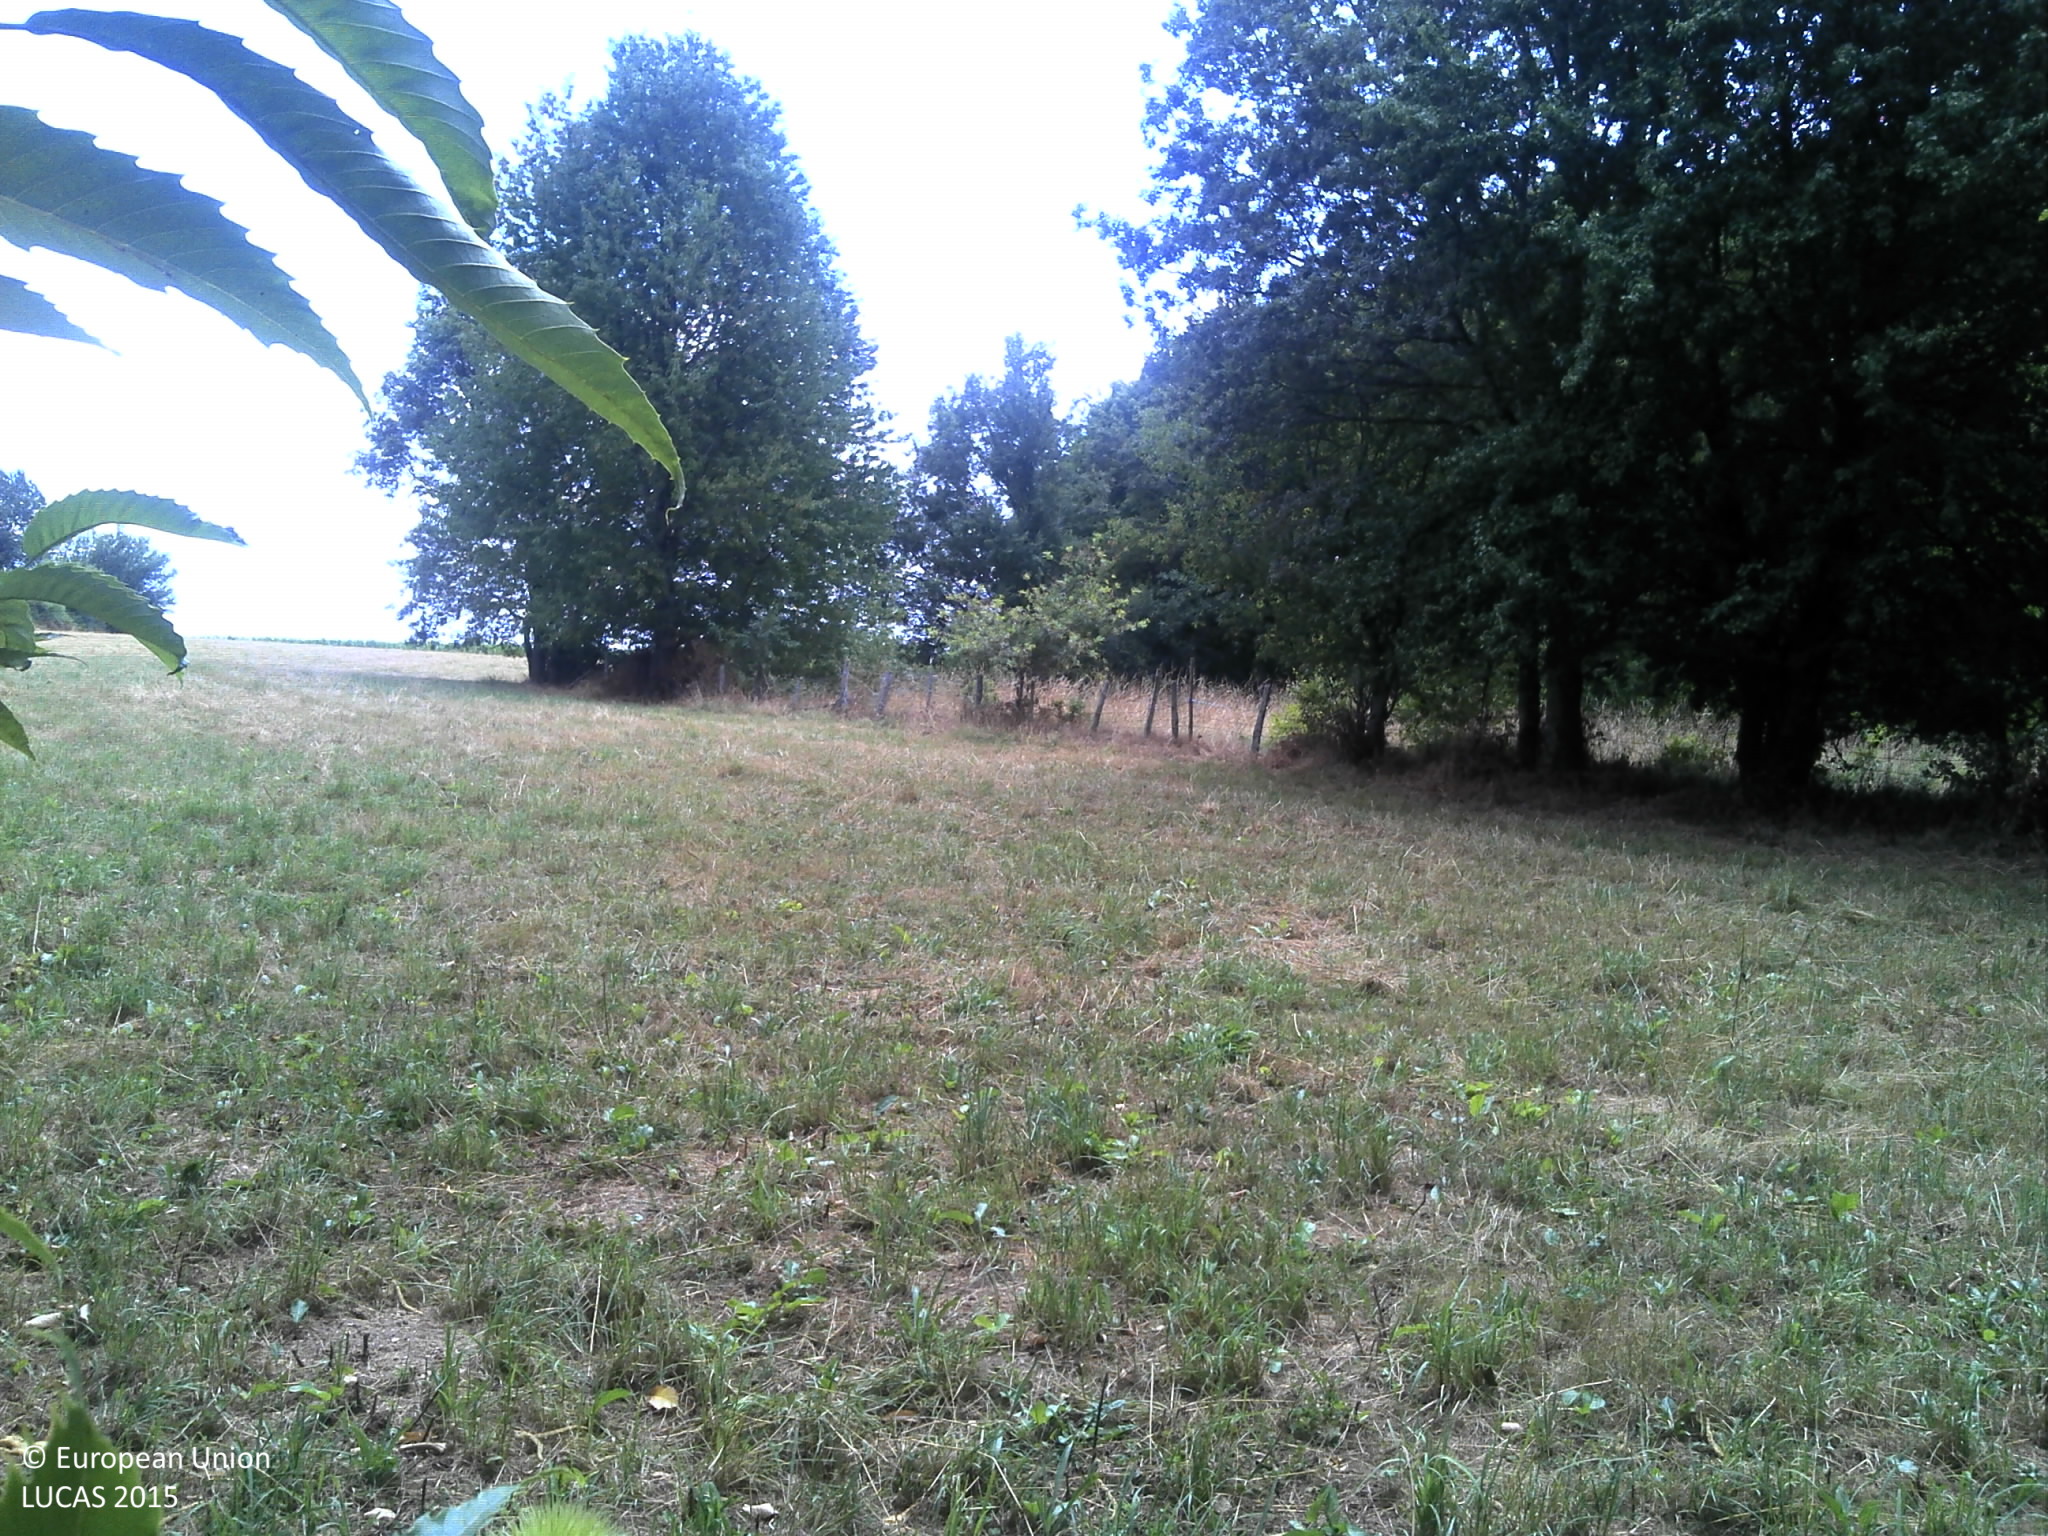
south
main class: Grassland
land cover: Grassland without tree/shrub cover
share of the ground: > 75 %
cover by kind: herbaceous plants 90 %, unconsolidated bare surface 10 %
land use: Agriculture (excluding fallow land and kitchen gardens)
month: July
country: FR
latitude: 44.9790
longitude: 1.9456
